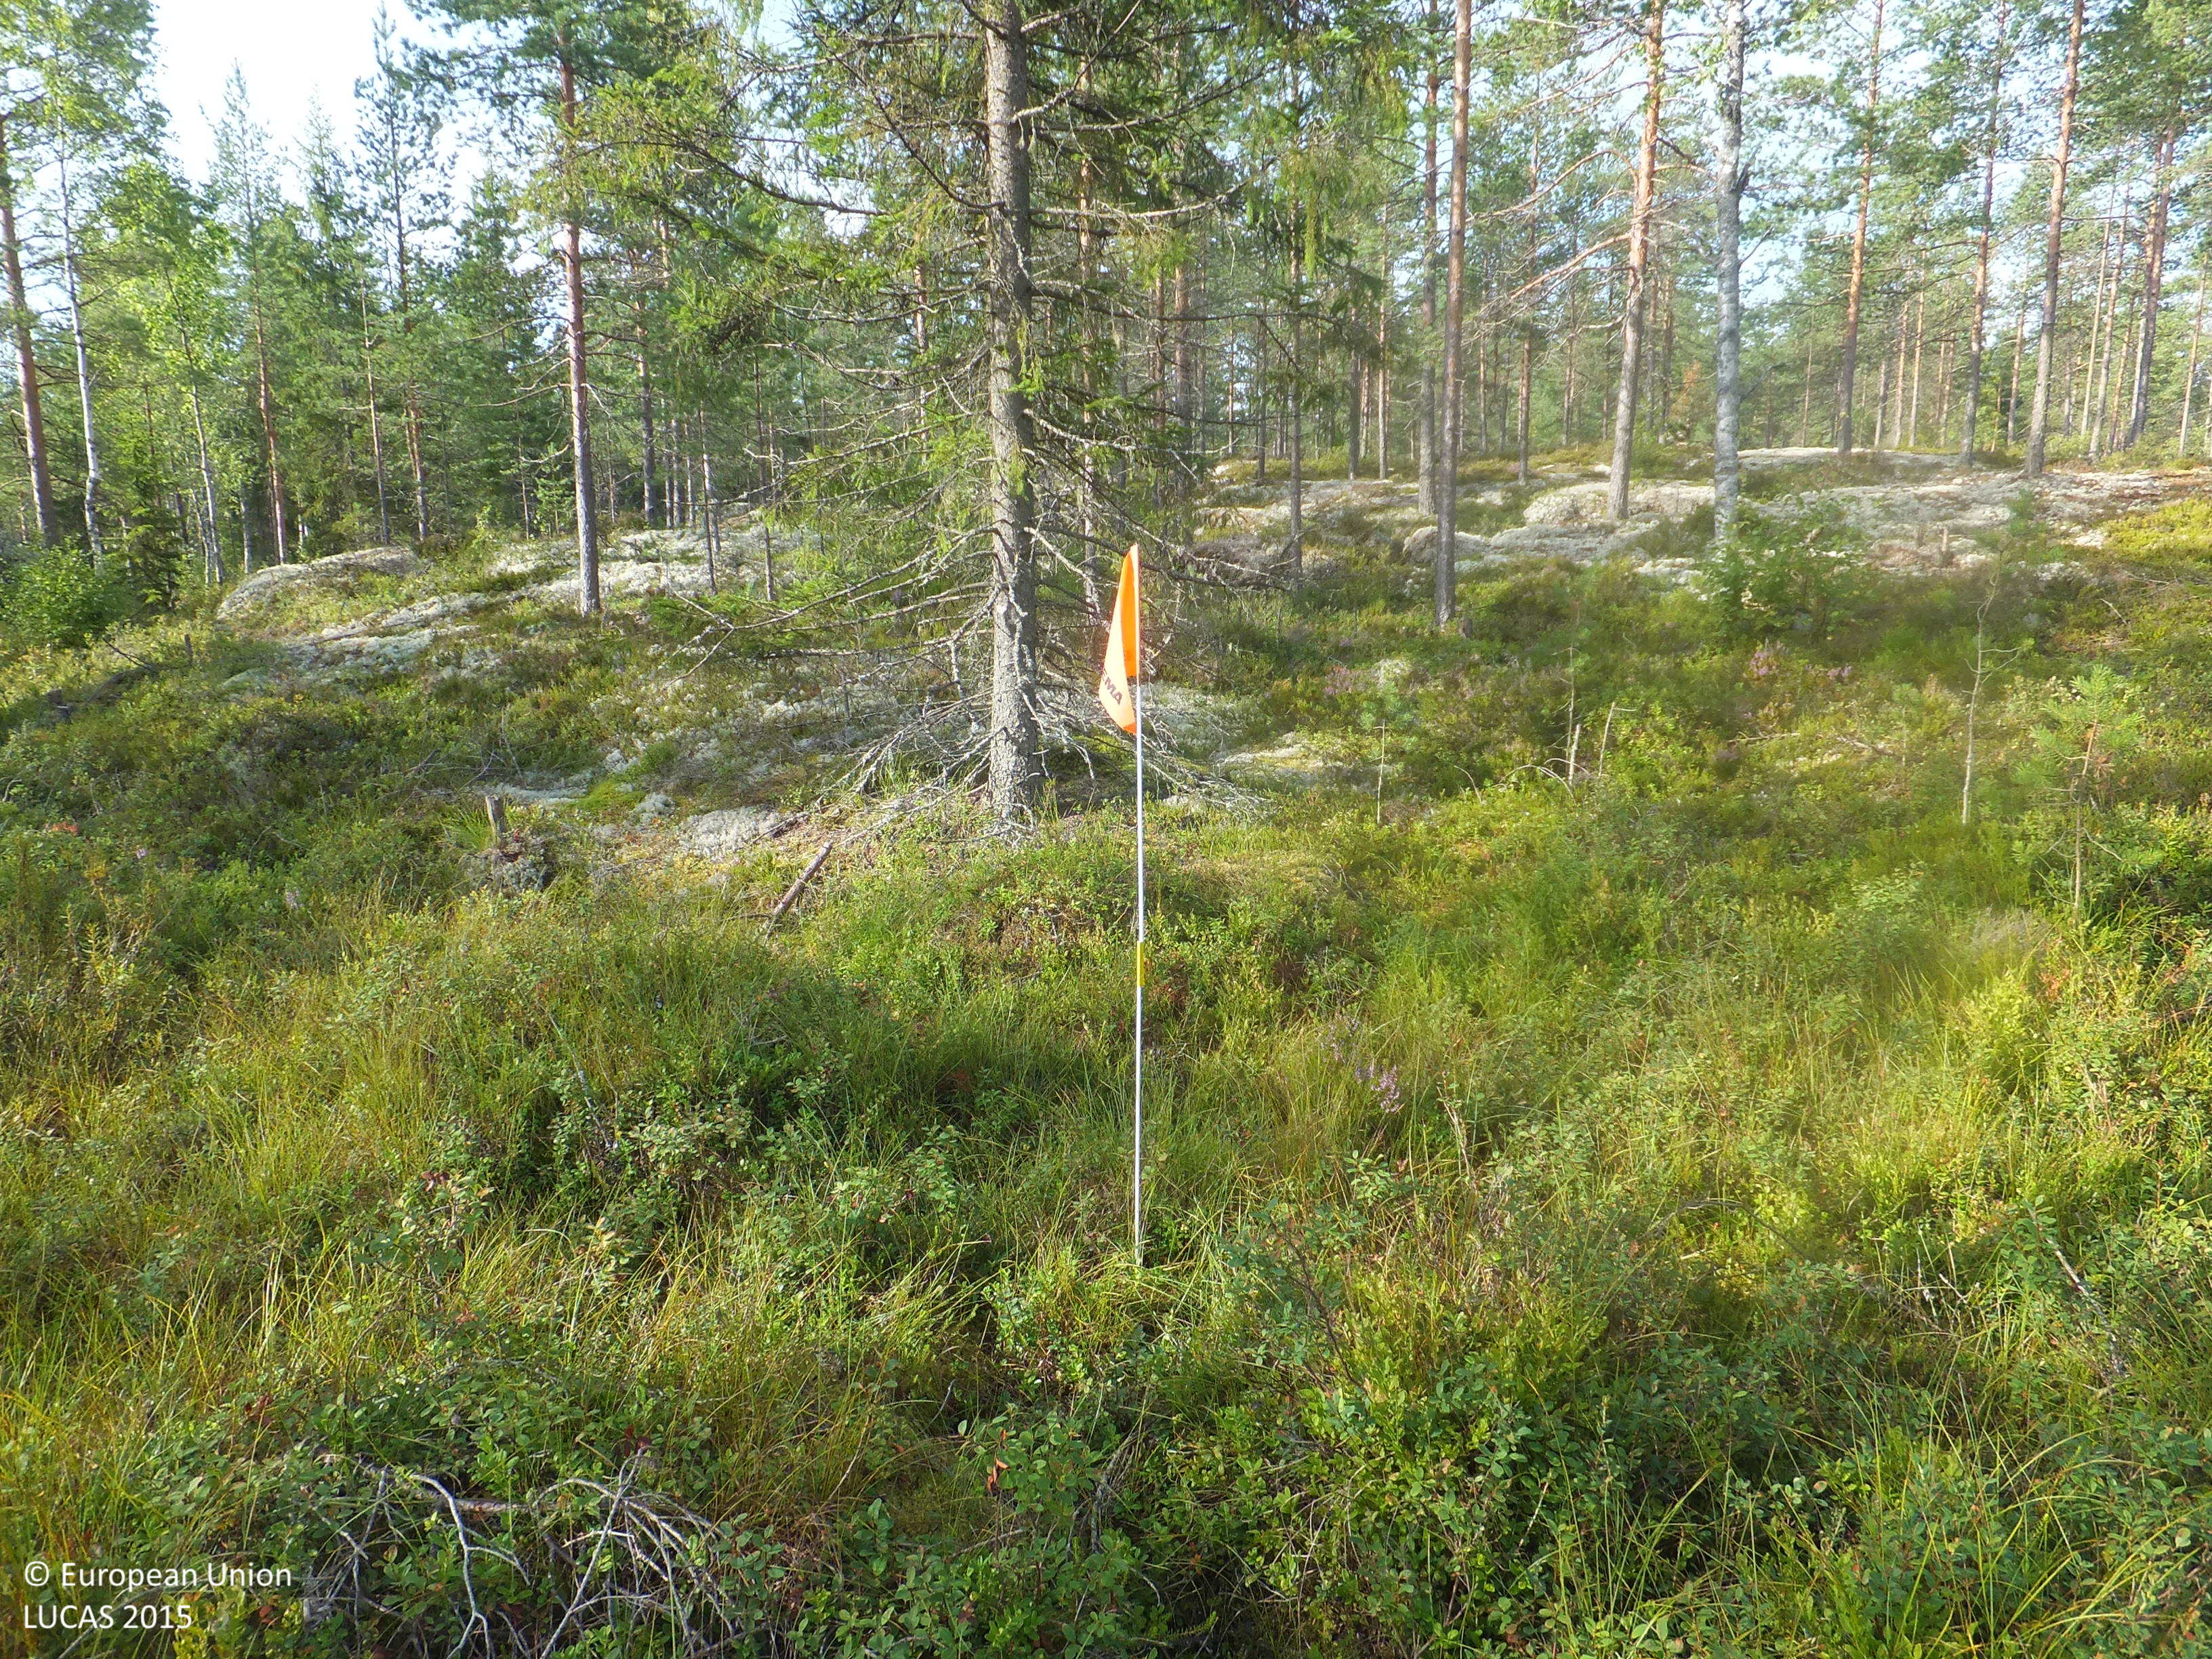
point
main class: Woodland
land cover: Pine dominated coniferous woodland
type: boreal forest
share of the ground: 25 - 50 %
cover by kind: coniferous forest trees 35 %, shrubs 30 %, lichens and mosses 15 %, herbaceous plants 10 %, broadleaved forest trees 5 %, consolidated bare surface 5 %
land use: Forestry
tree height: > 5 m
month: August
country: FI
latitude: 63.1442
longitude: 23.0142
